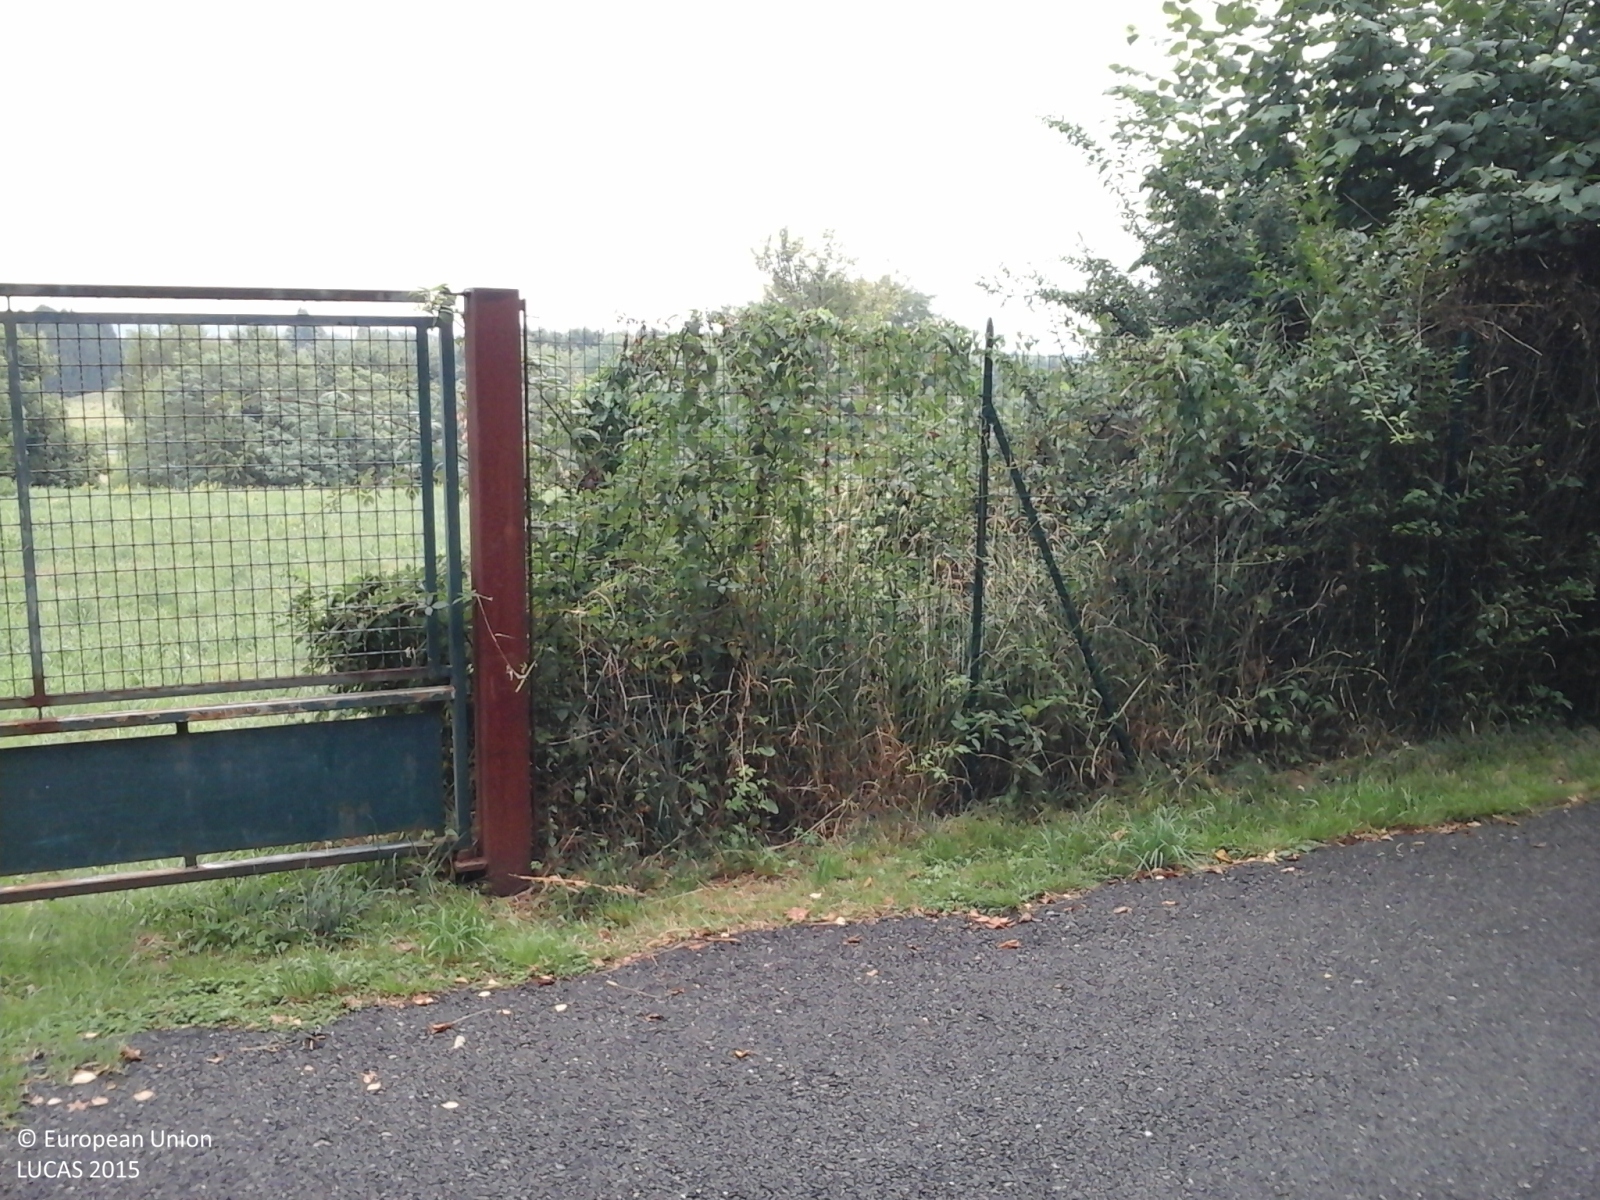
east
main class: Grassland
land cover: Grassland without tree/shrub cover
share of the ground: > 75 %
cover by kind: herbaceous plants 100 %
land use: Residential
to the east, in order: Grassland without tree/shrub cover; Managed hedges; Fences; Electric lines; Paved roads, cycling and walking lanes; Electric lines; Fences; Managed hedges; Grassland without tree/shrub cover; Abandoned hedges; Lucerne
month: August
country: IT
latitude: 45.6629
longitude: 9.1158
